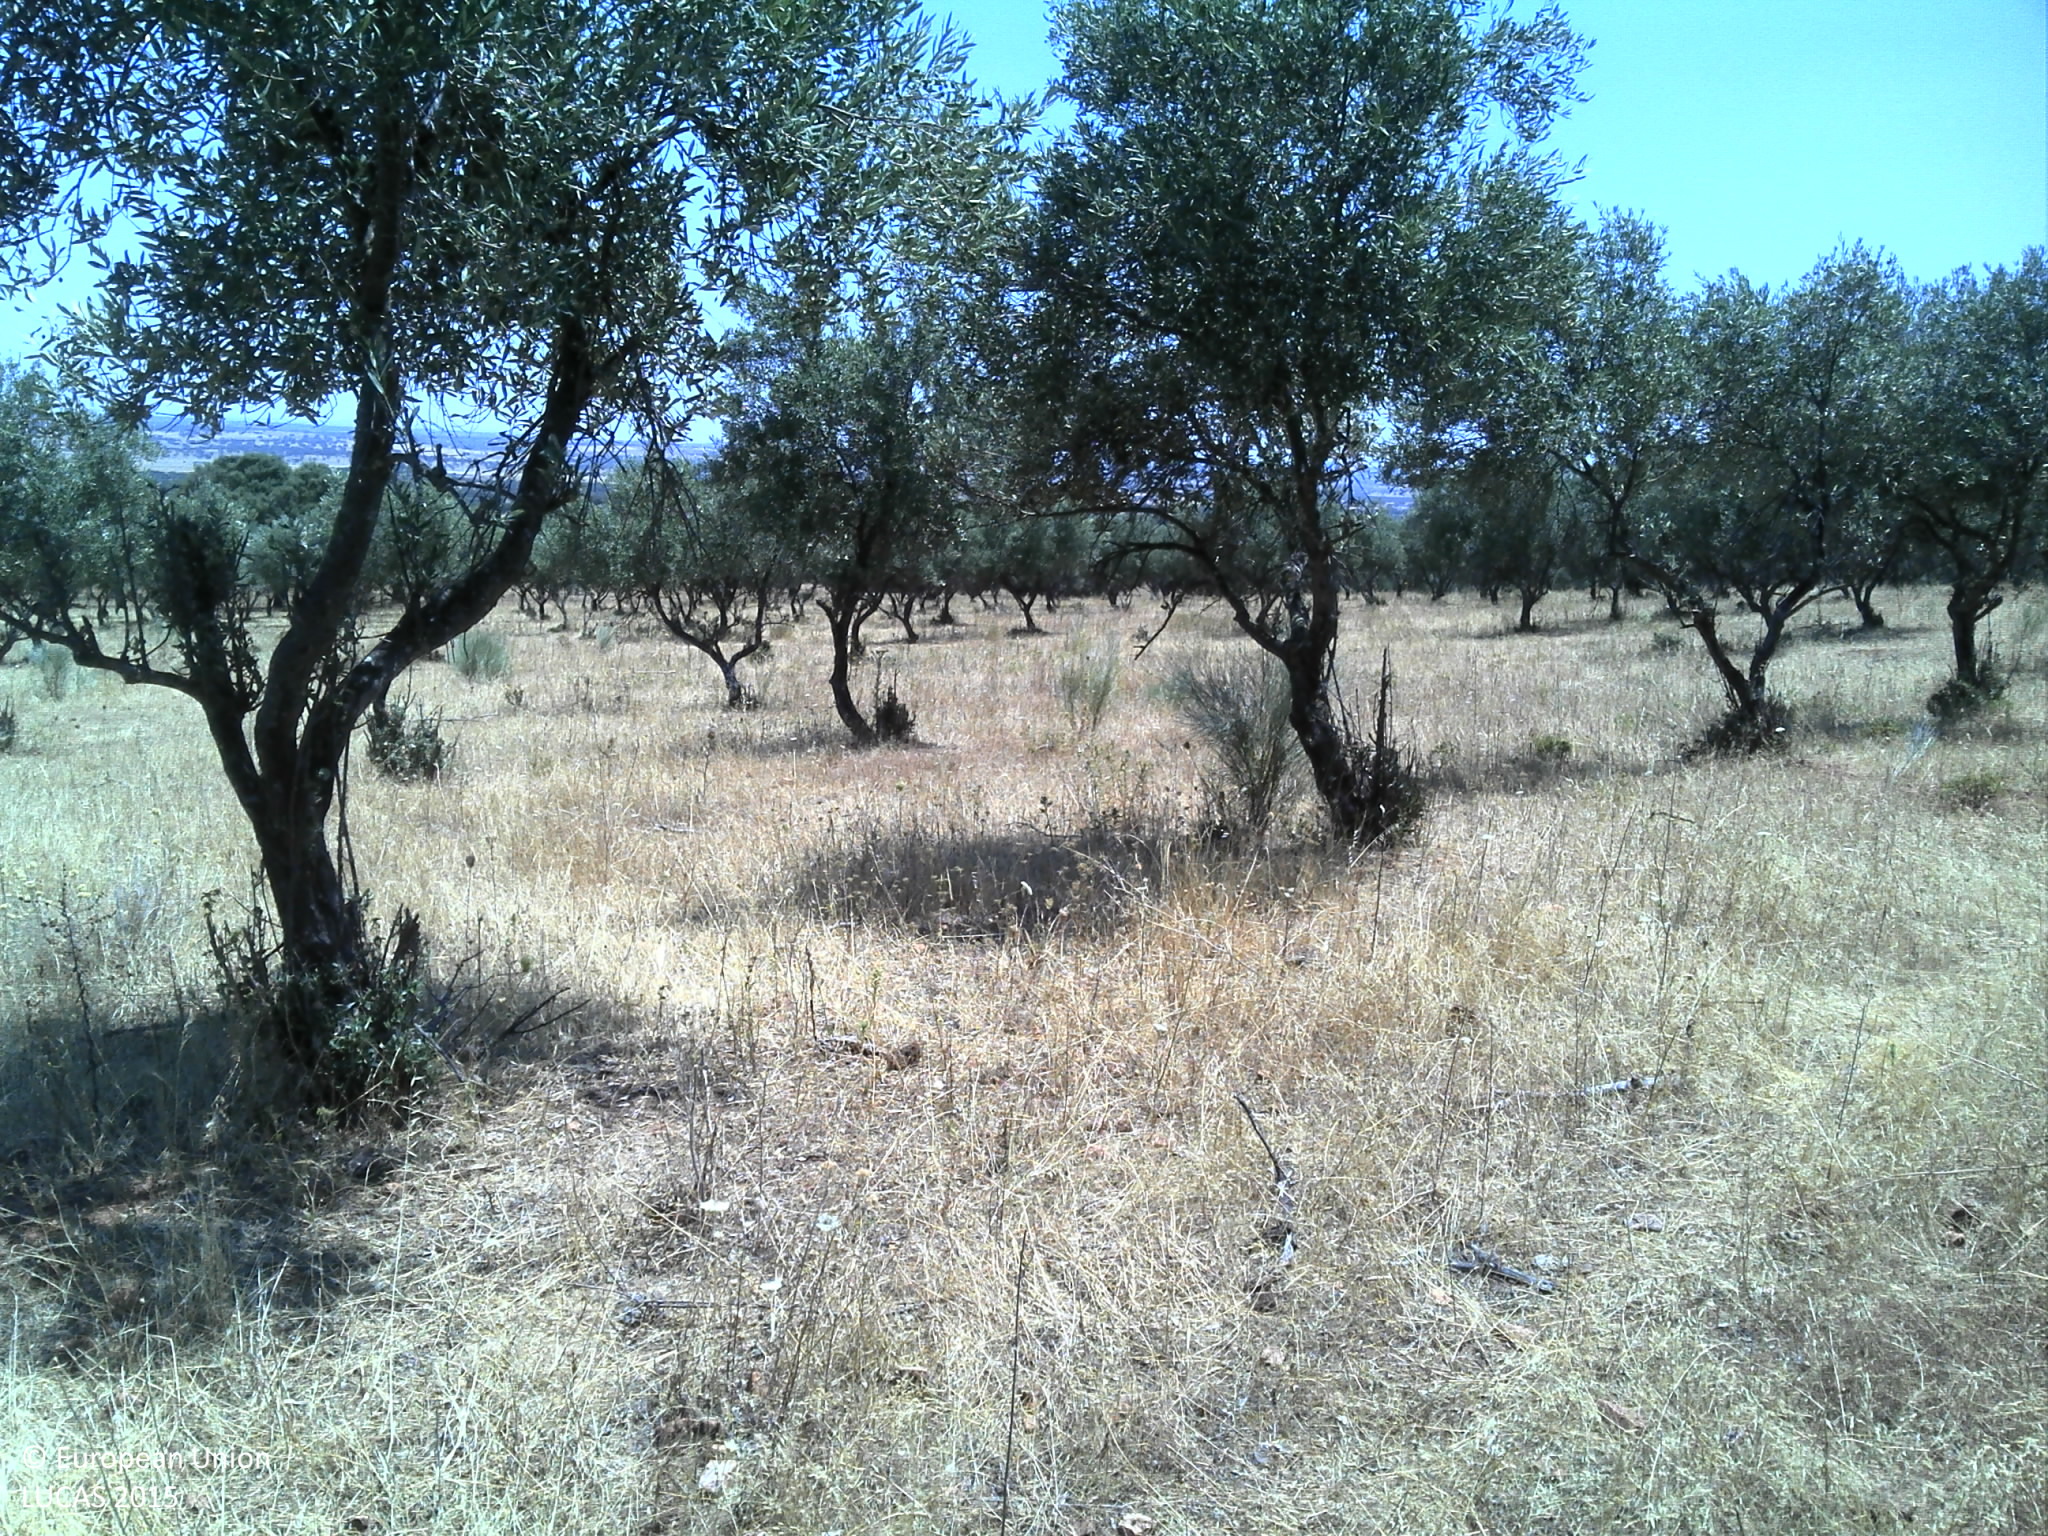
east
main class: Cropland
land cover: Olive groves
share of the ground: 25 - 50 %
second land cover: Grassland without tree/shrub cover
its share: 50 - 75 %
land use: Agriculture (excluding fallow land and kitchen gardens)
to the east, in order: Olive groves; Grassland without tree/shrub cover; Olive groves; Fences; Broadleaved woodland; Tracks; Broadleaved woodland
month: June
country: PT
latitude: 38.0519
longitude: -7.3036
